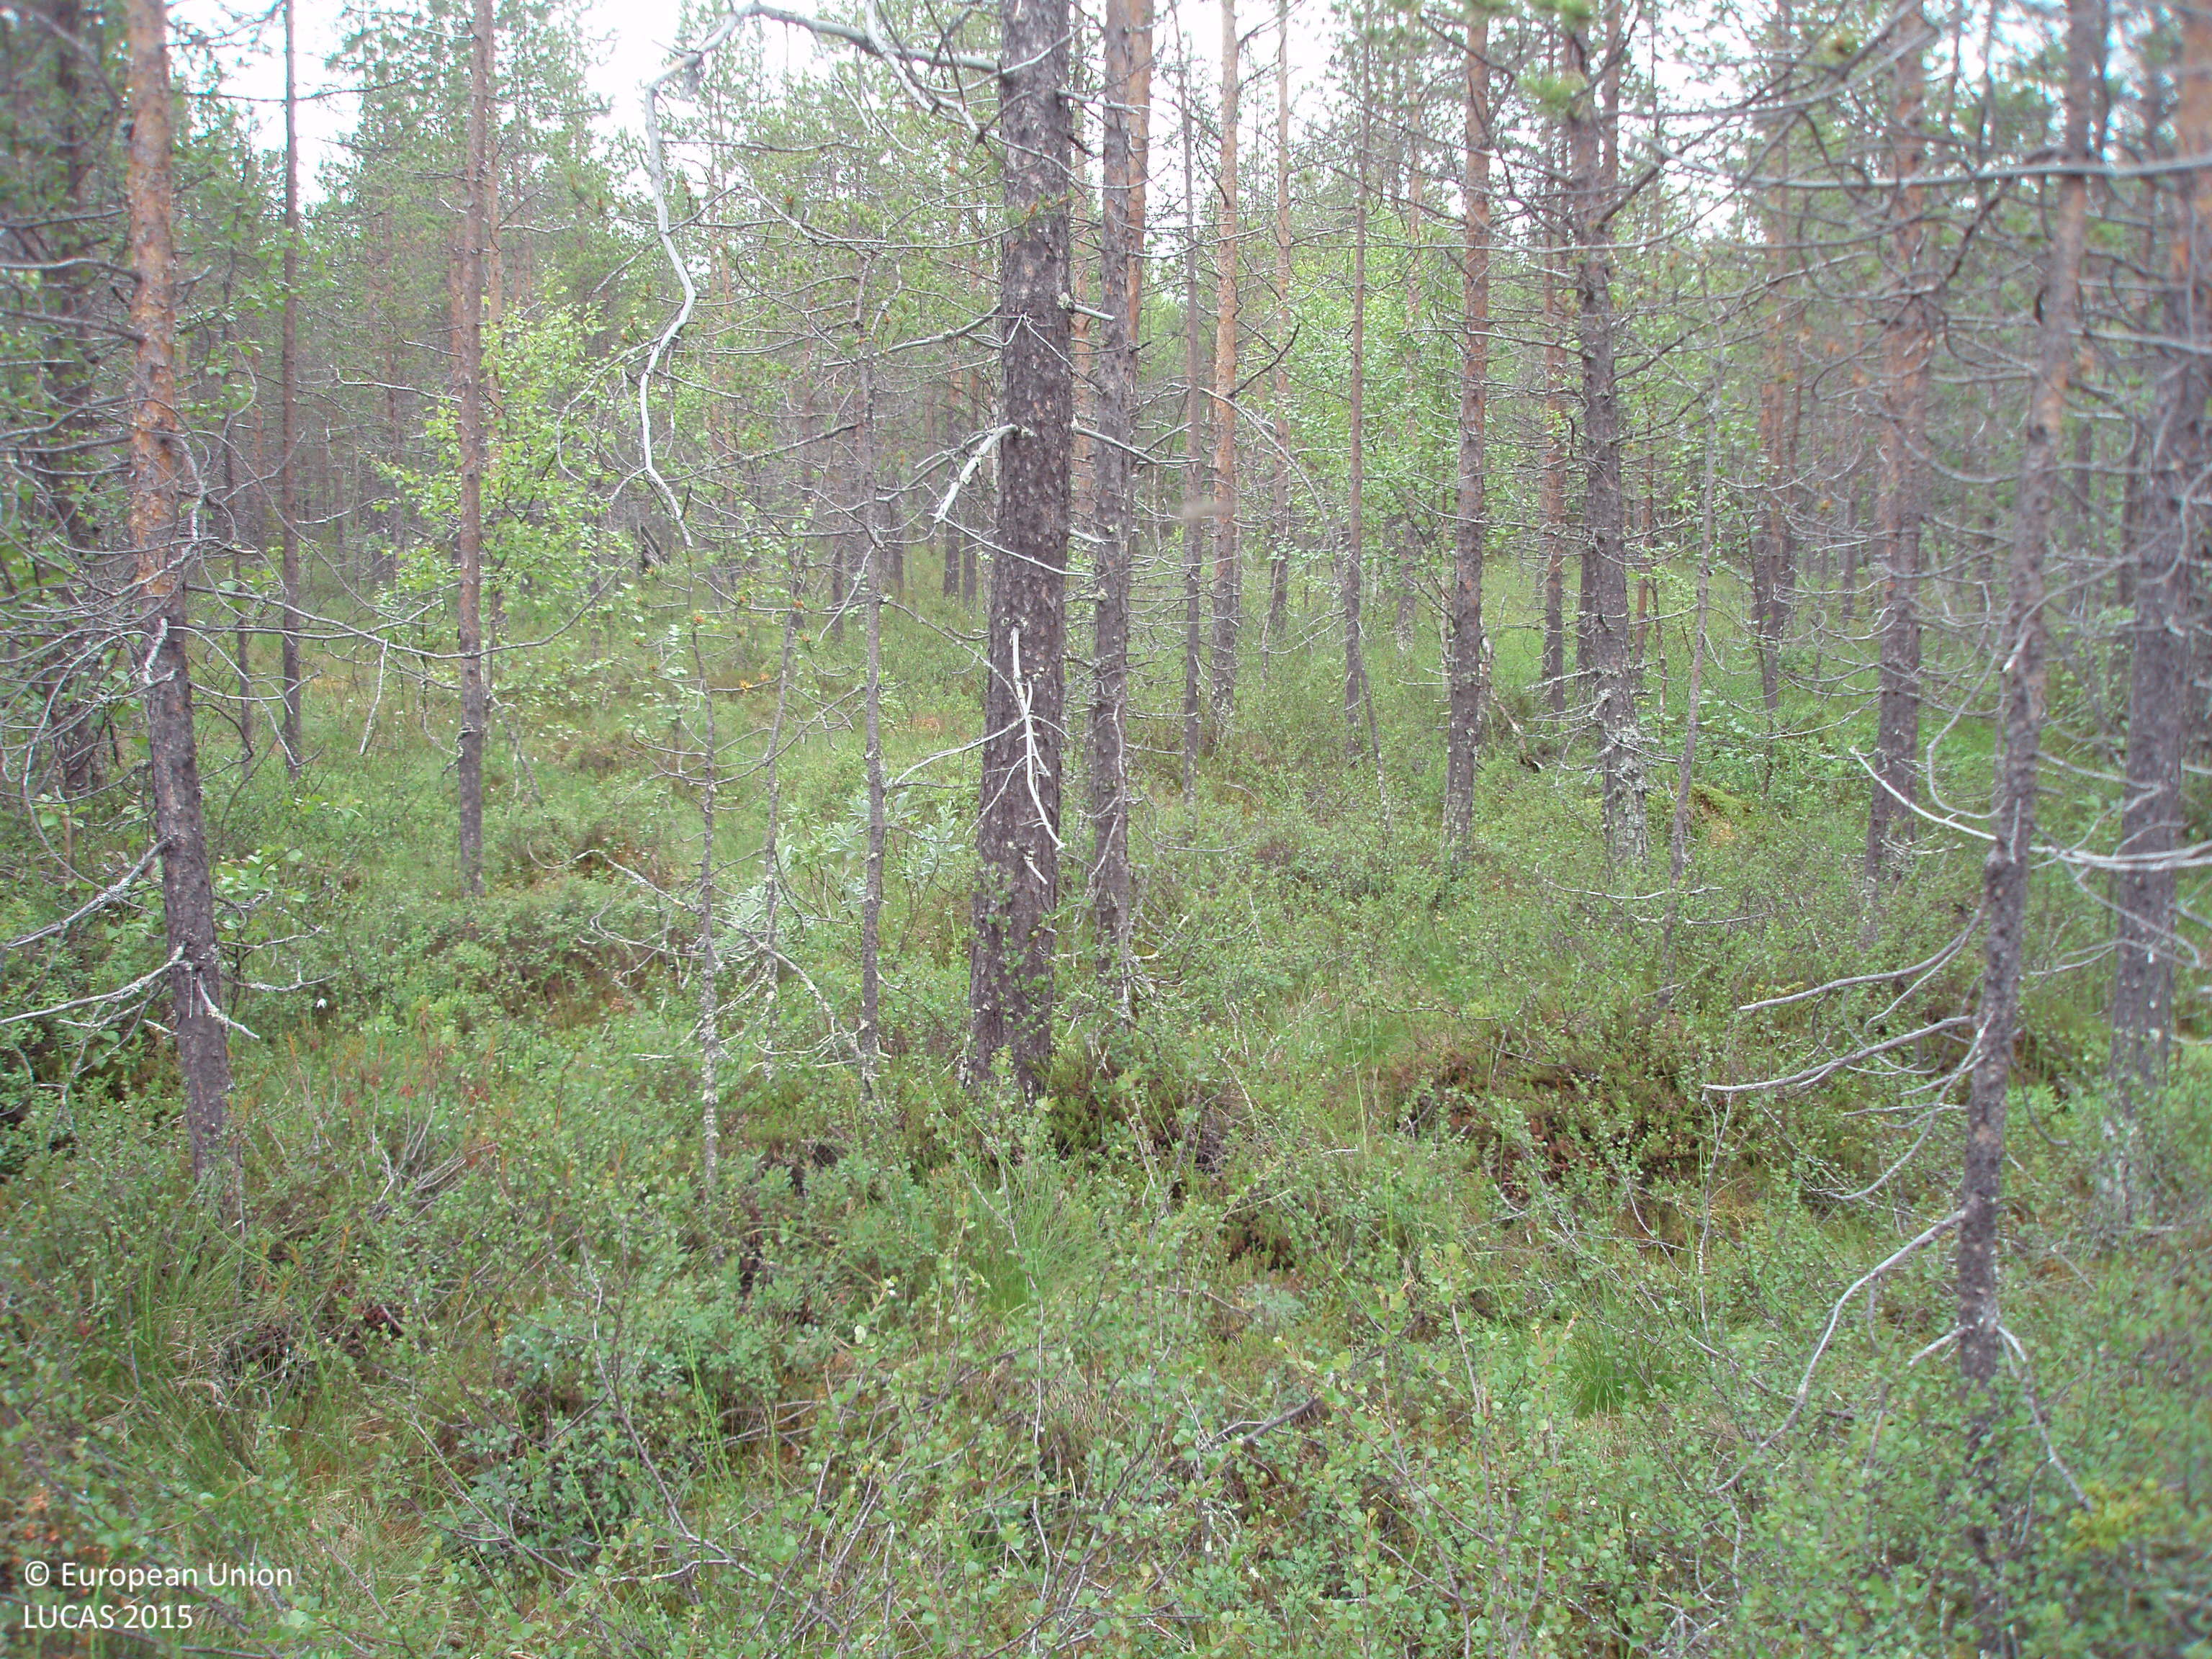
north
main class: Woodland
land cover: Pine dominated coniferous woodland
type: mire and swamp forests
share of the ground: 25 - 50 %
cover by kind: shrubs 45 %, coniferous forest trees 40 %, lichens and mosses 10 %, broadleaved forest trees 5 %
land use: Forestry
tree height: > 5 m
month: July
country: FI
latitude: 67.1963
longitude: 27.7040
